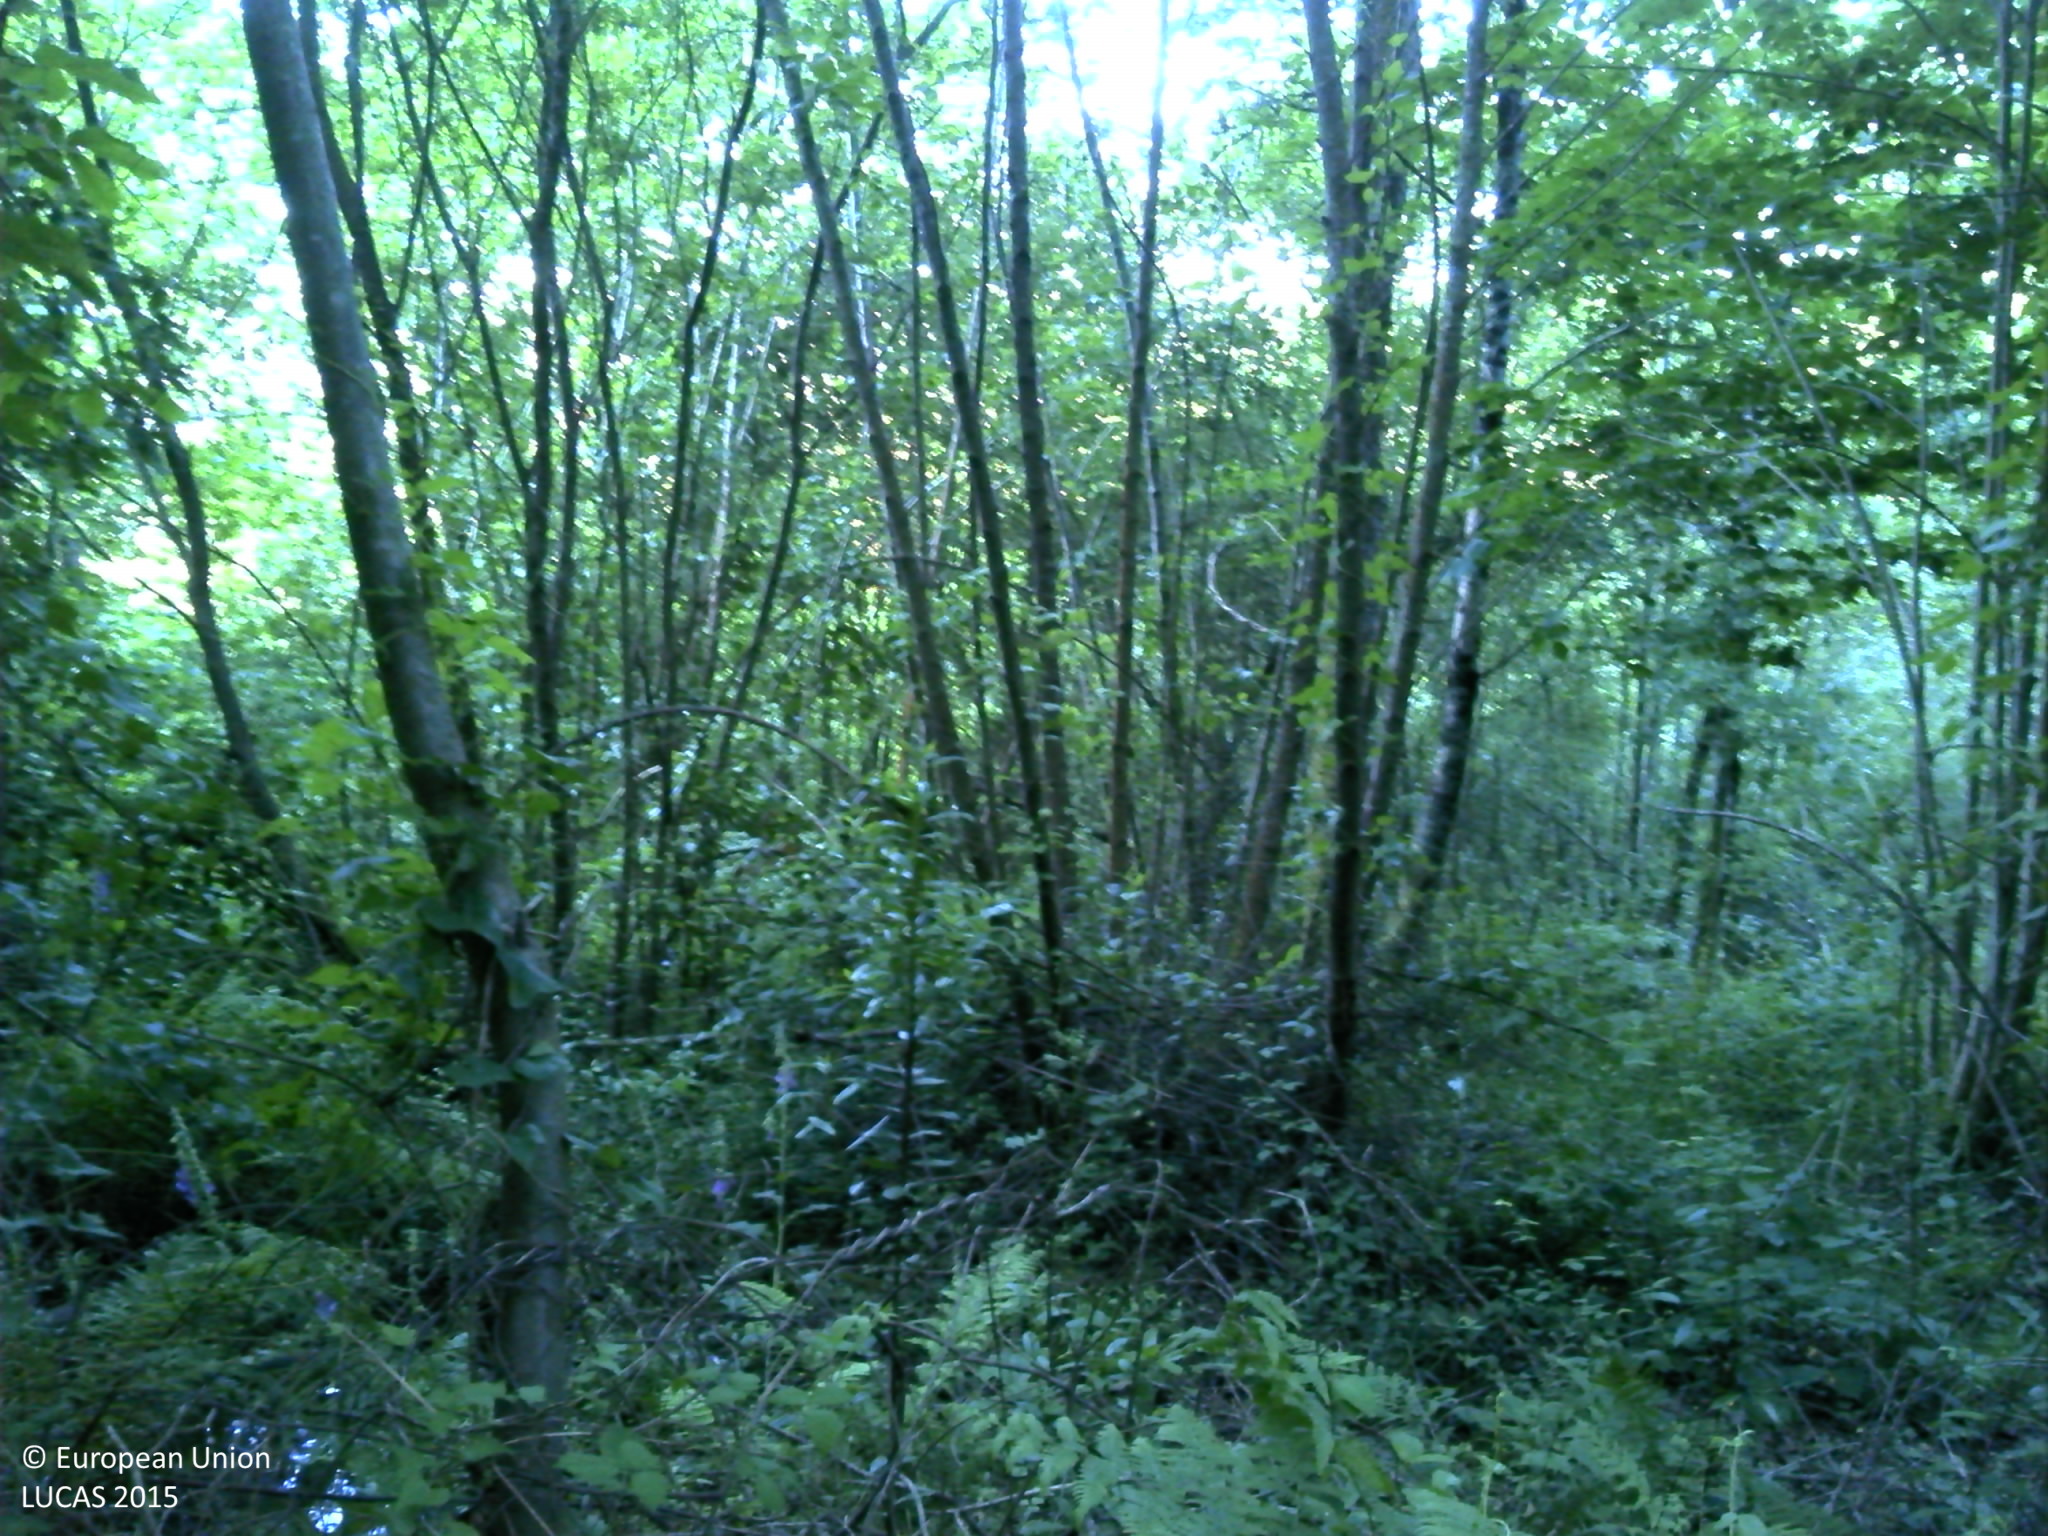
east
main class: Woodland
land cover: Broadleaved woodland
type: acidophilous oak and oak-birch forest
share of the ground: 50 - 75 %
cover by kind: broadleaved forest trees 75 %, shrubs 20 %, herbaceous plants 5 %
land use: Forestry
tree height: > 5 m
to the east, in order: Broadleaved woodland; Paved roads, cycling and walking lanes; Broadleaved woodland
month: May
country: PT
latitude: 41.9375
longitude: -8.6567
